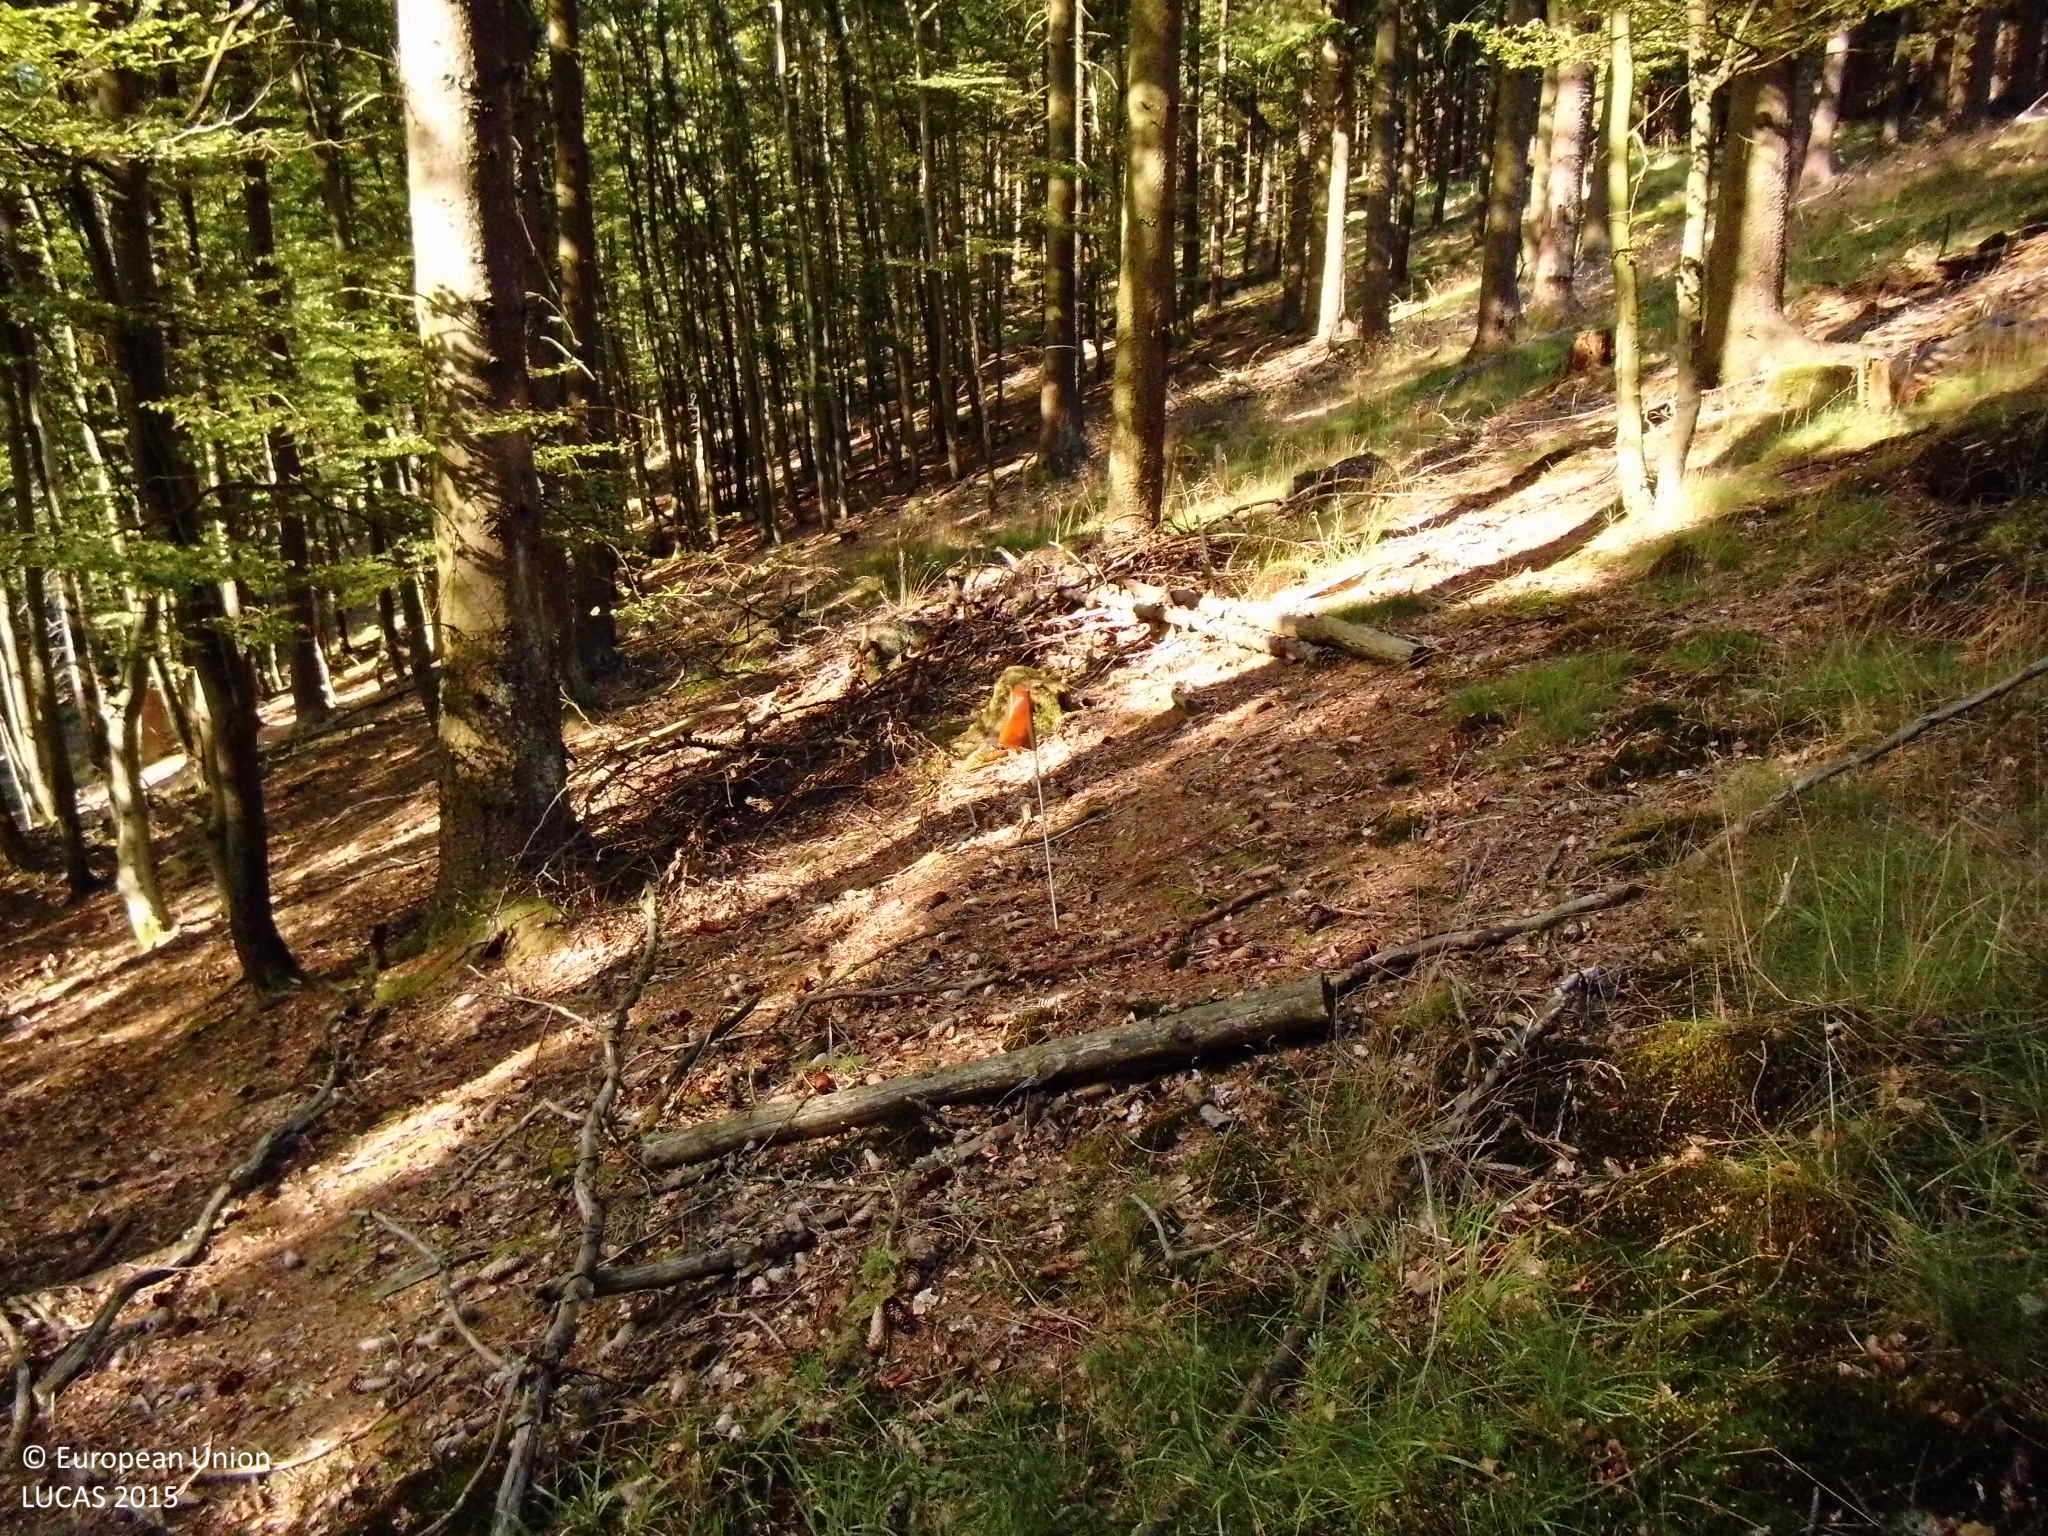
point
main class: Woodland
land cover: Spruce dominated mixed woodland
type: hemiboreal forest and nemoral coniferous forest and mixed broadleaved-coniferous forest
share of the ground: > 75 %
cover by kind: coniferous forest trees 40 %, broadleaved forest trees 40 %, herbaceous plants 10 %, lichens and mosses 5 %, unconsolidated bare surface 5 %
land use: Forestry
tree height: > 5 m
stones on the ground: < 10 %
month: August
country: DE
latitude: 51.1271
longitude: 8.4714
